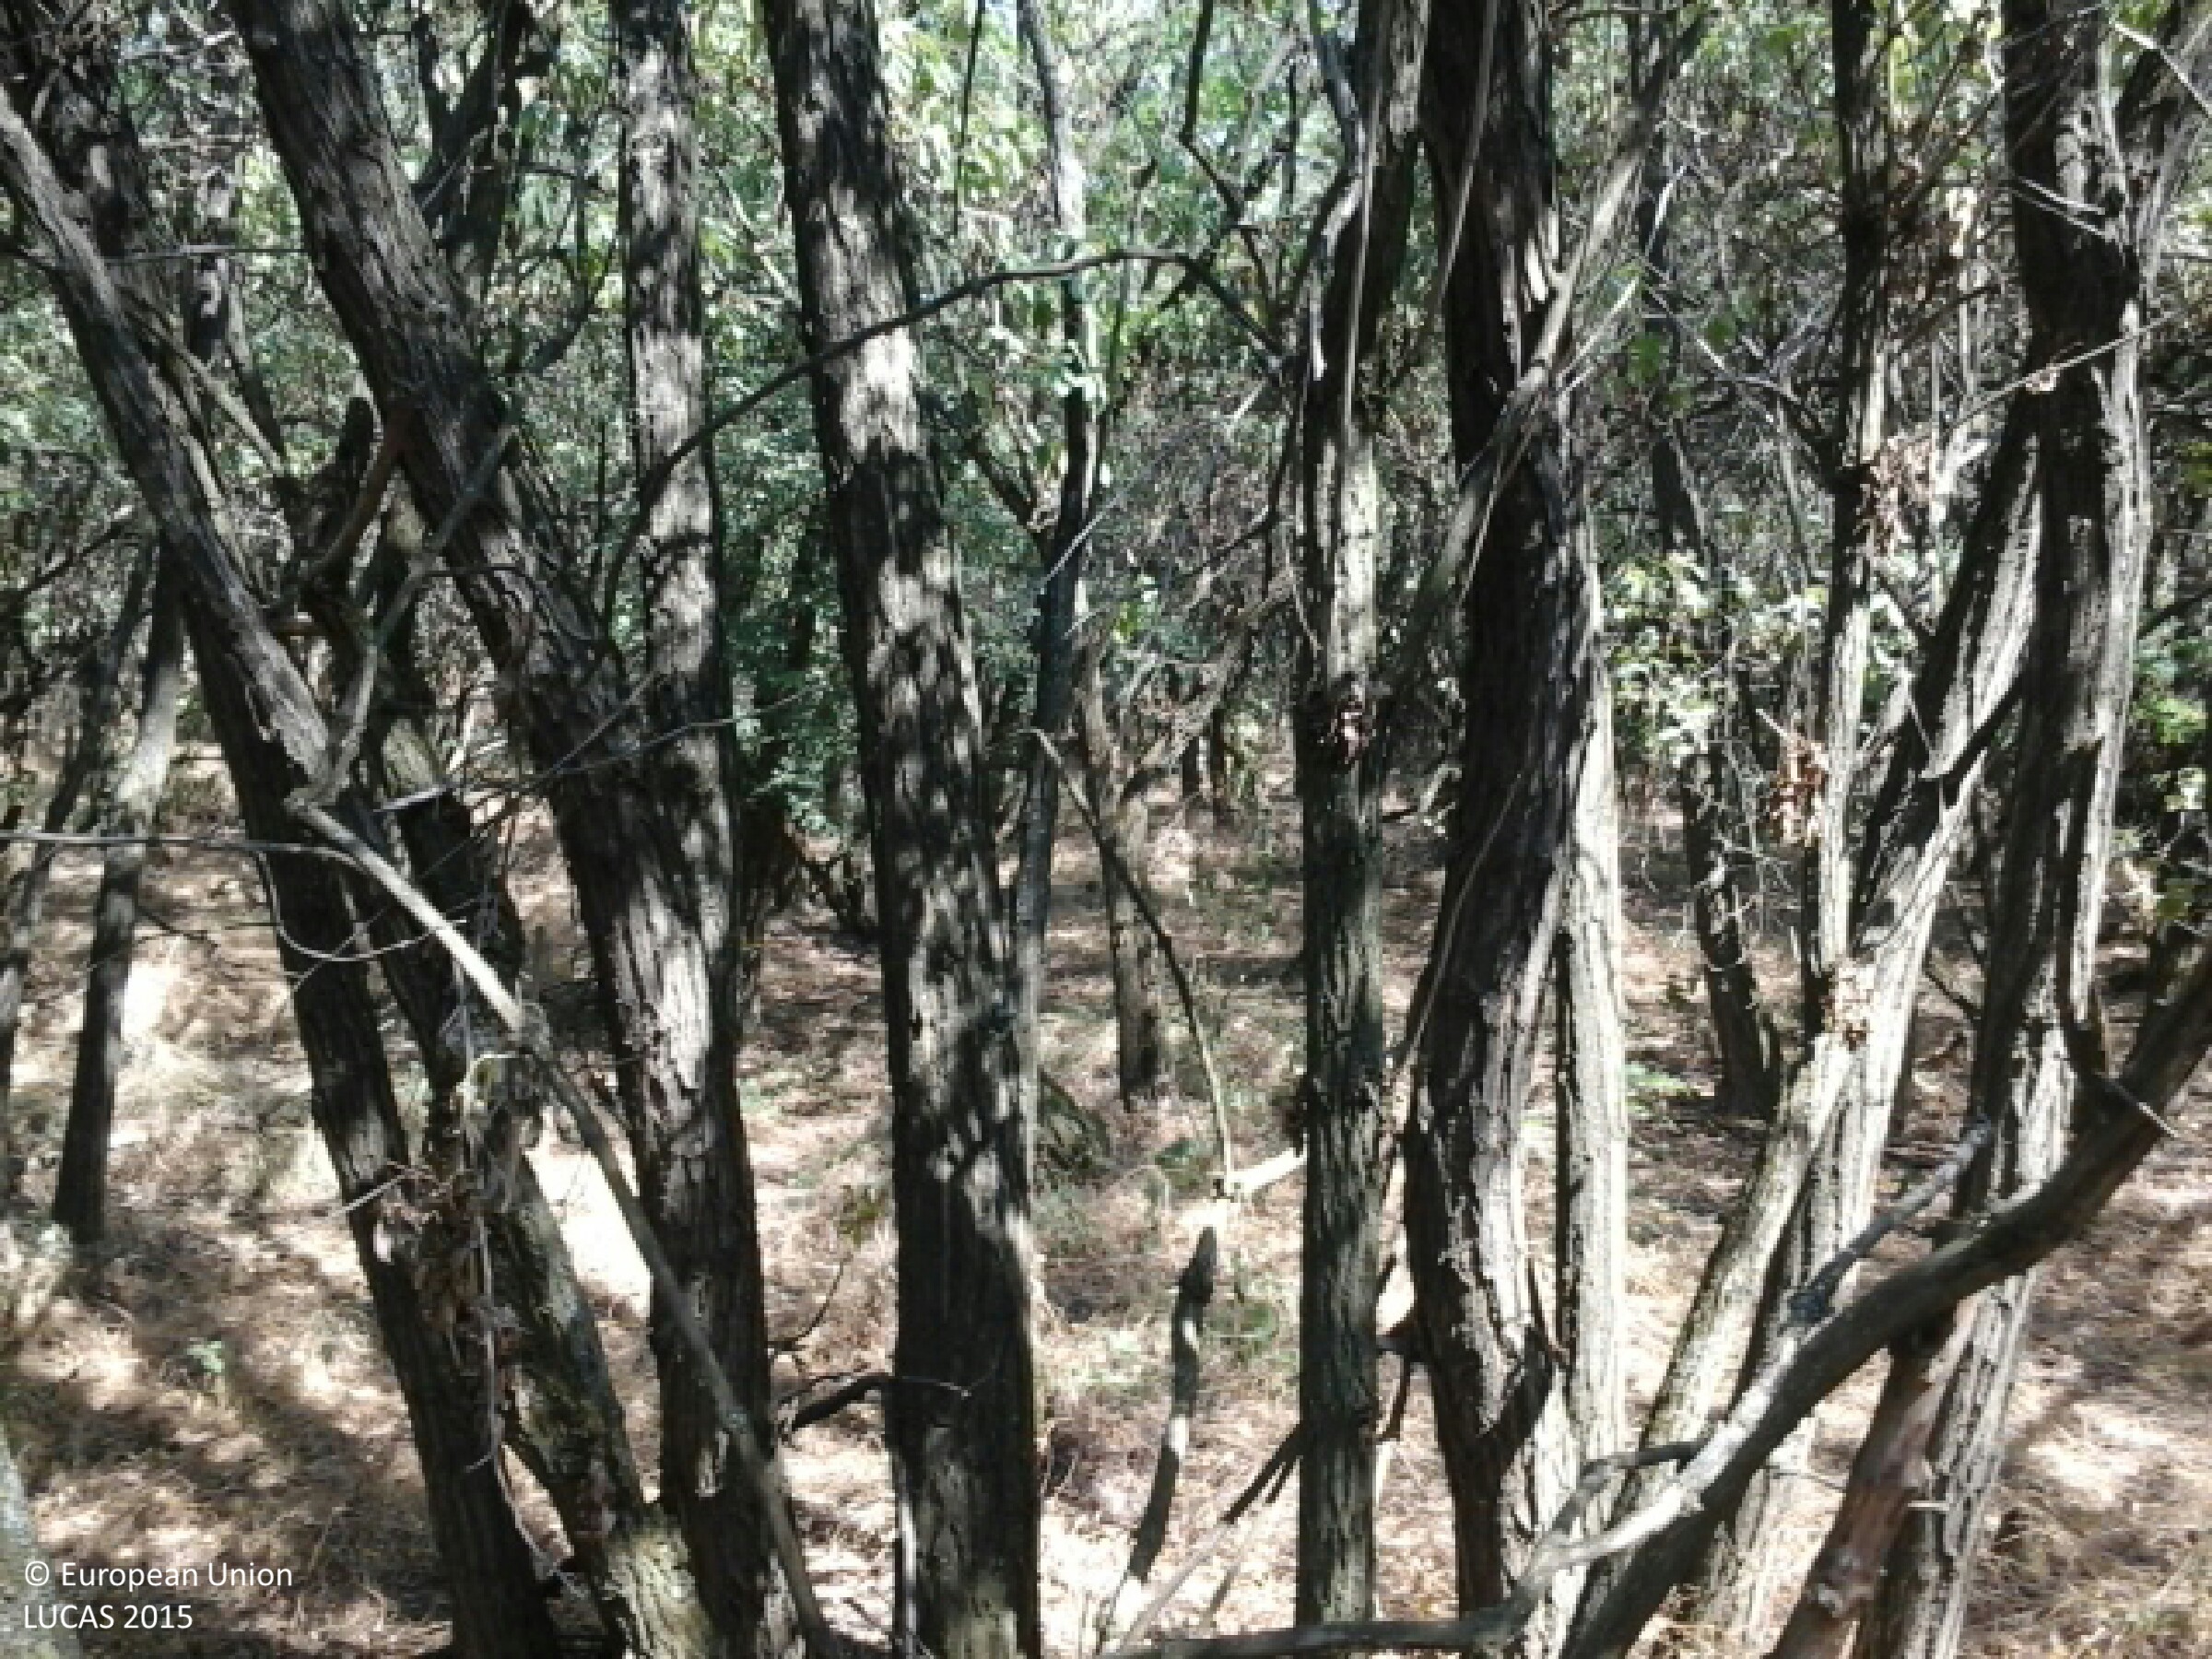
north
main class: Woodland
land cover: Broadleaved woodland
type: mesophytic deciduous forest
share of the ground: > 75 %
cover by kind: broadleaved forest trees 100 %
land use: Forestry
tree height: > 5 m
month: July
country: HU
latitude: 48.1689
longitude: 21.1072
